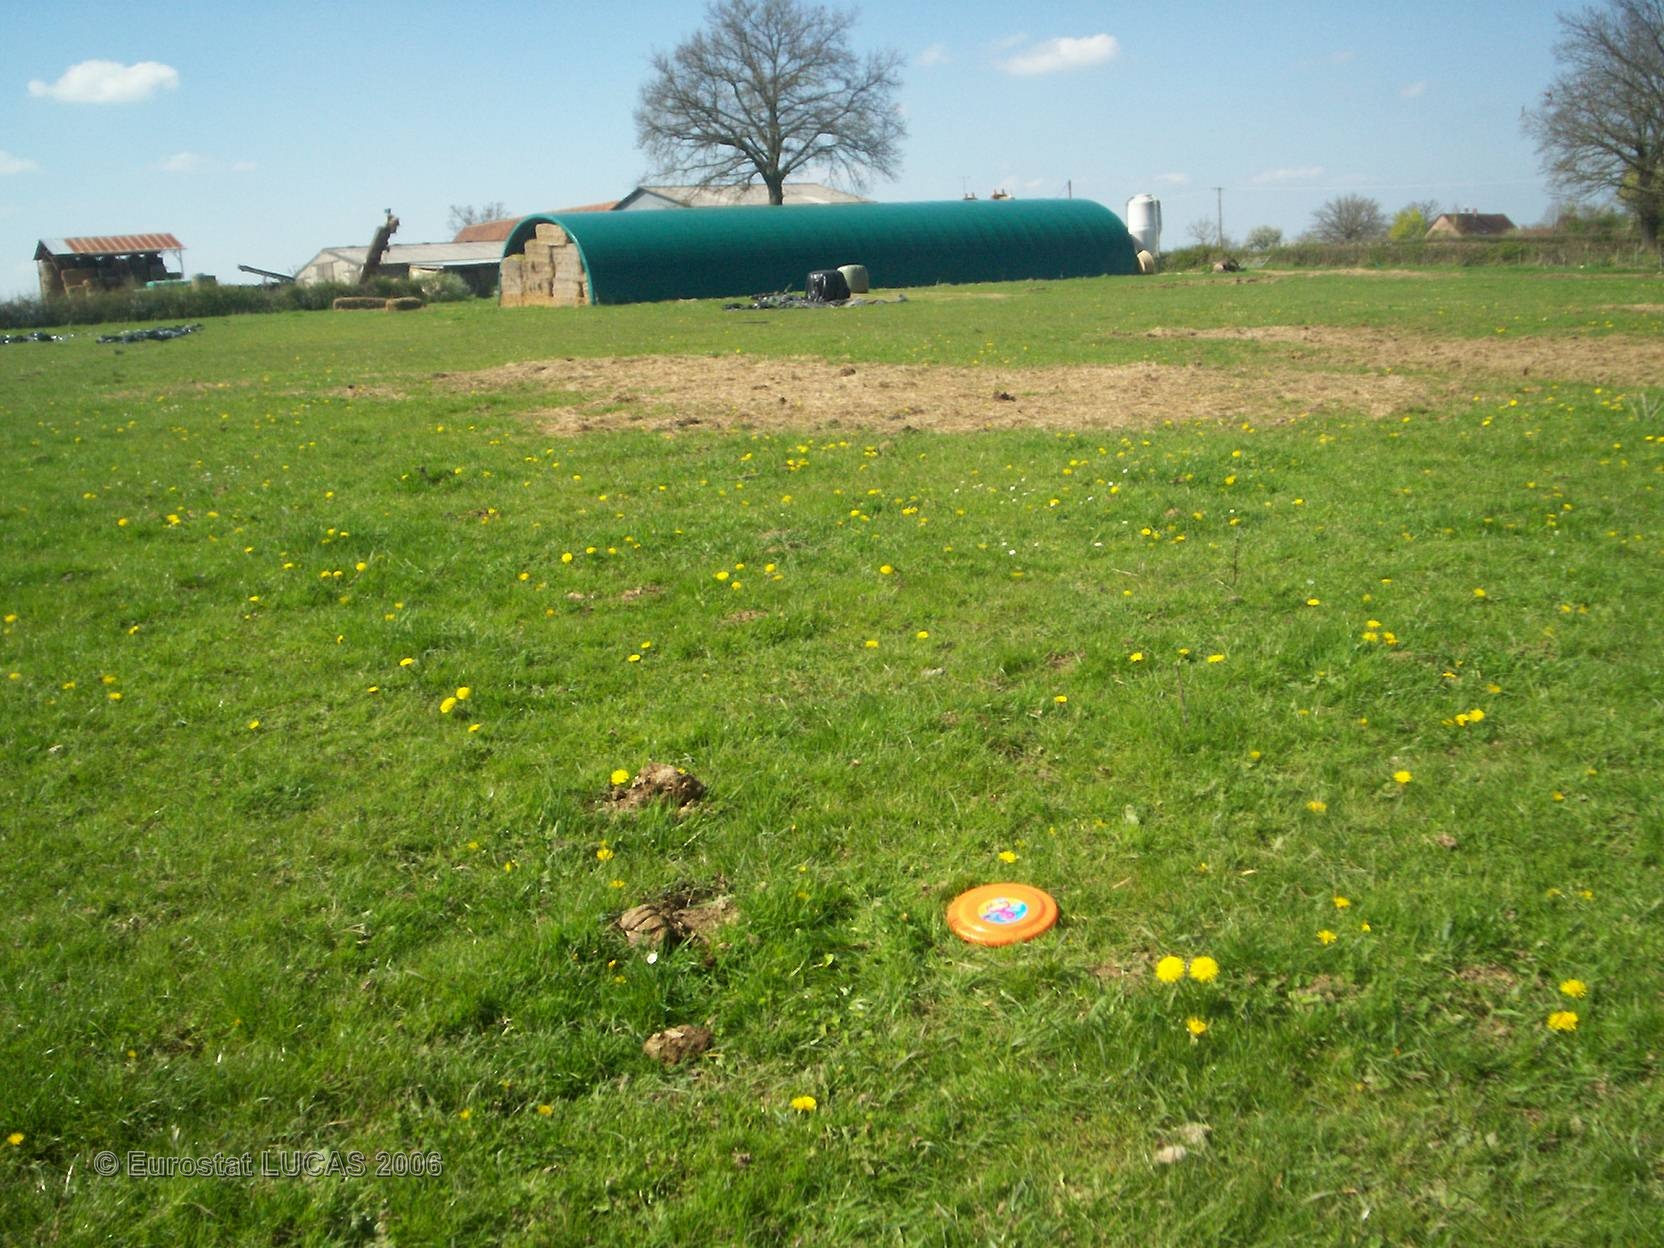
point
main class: Grassland
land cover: Grassland without tree/shrub cover
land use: Agriculture (excluding fallow land and kitchen gardens)
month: April
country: FR
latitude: 46.6189
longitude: 3.1415
